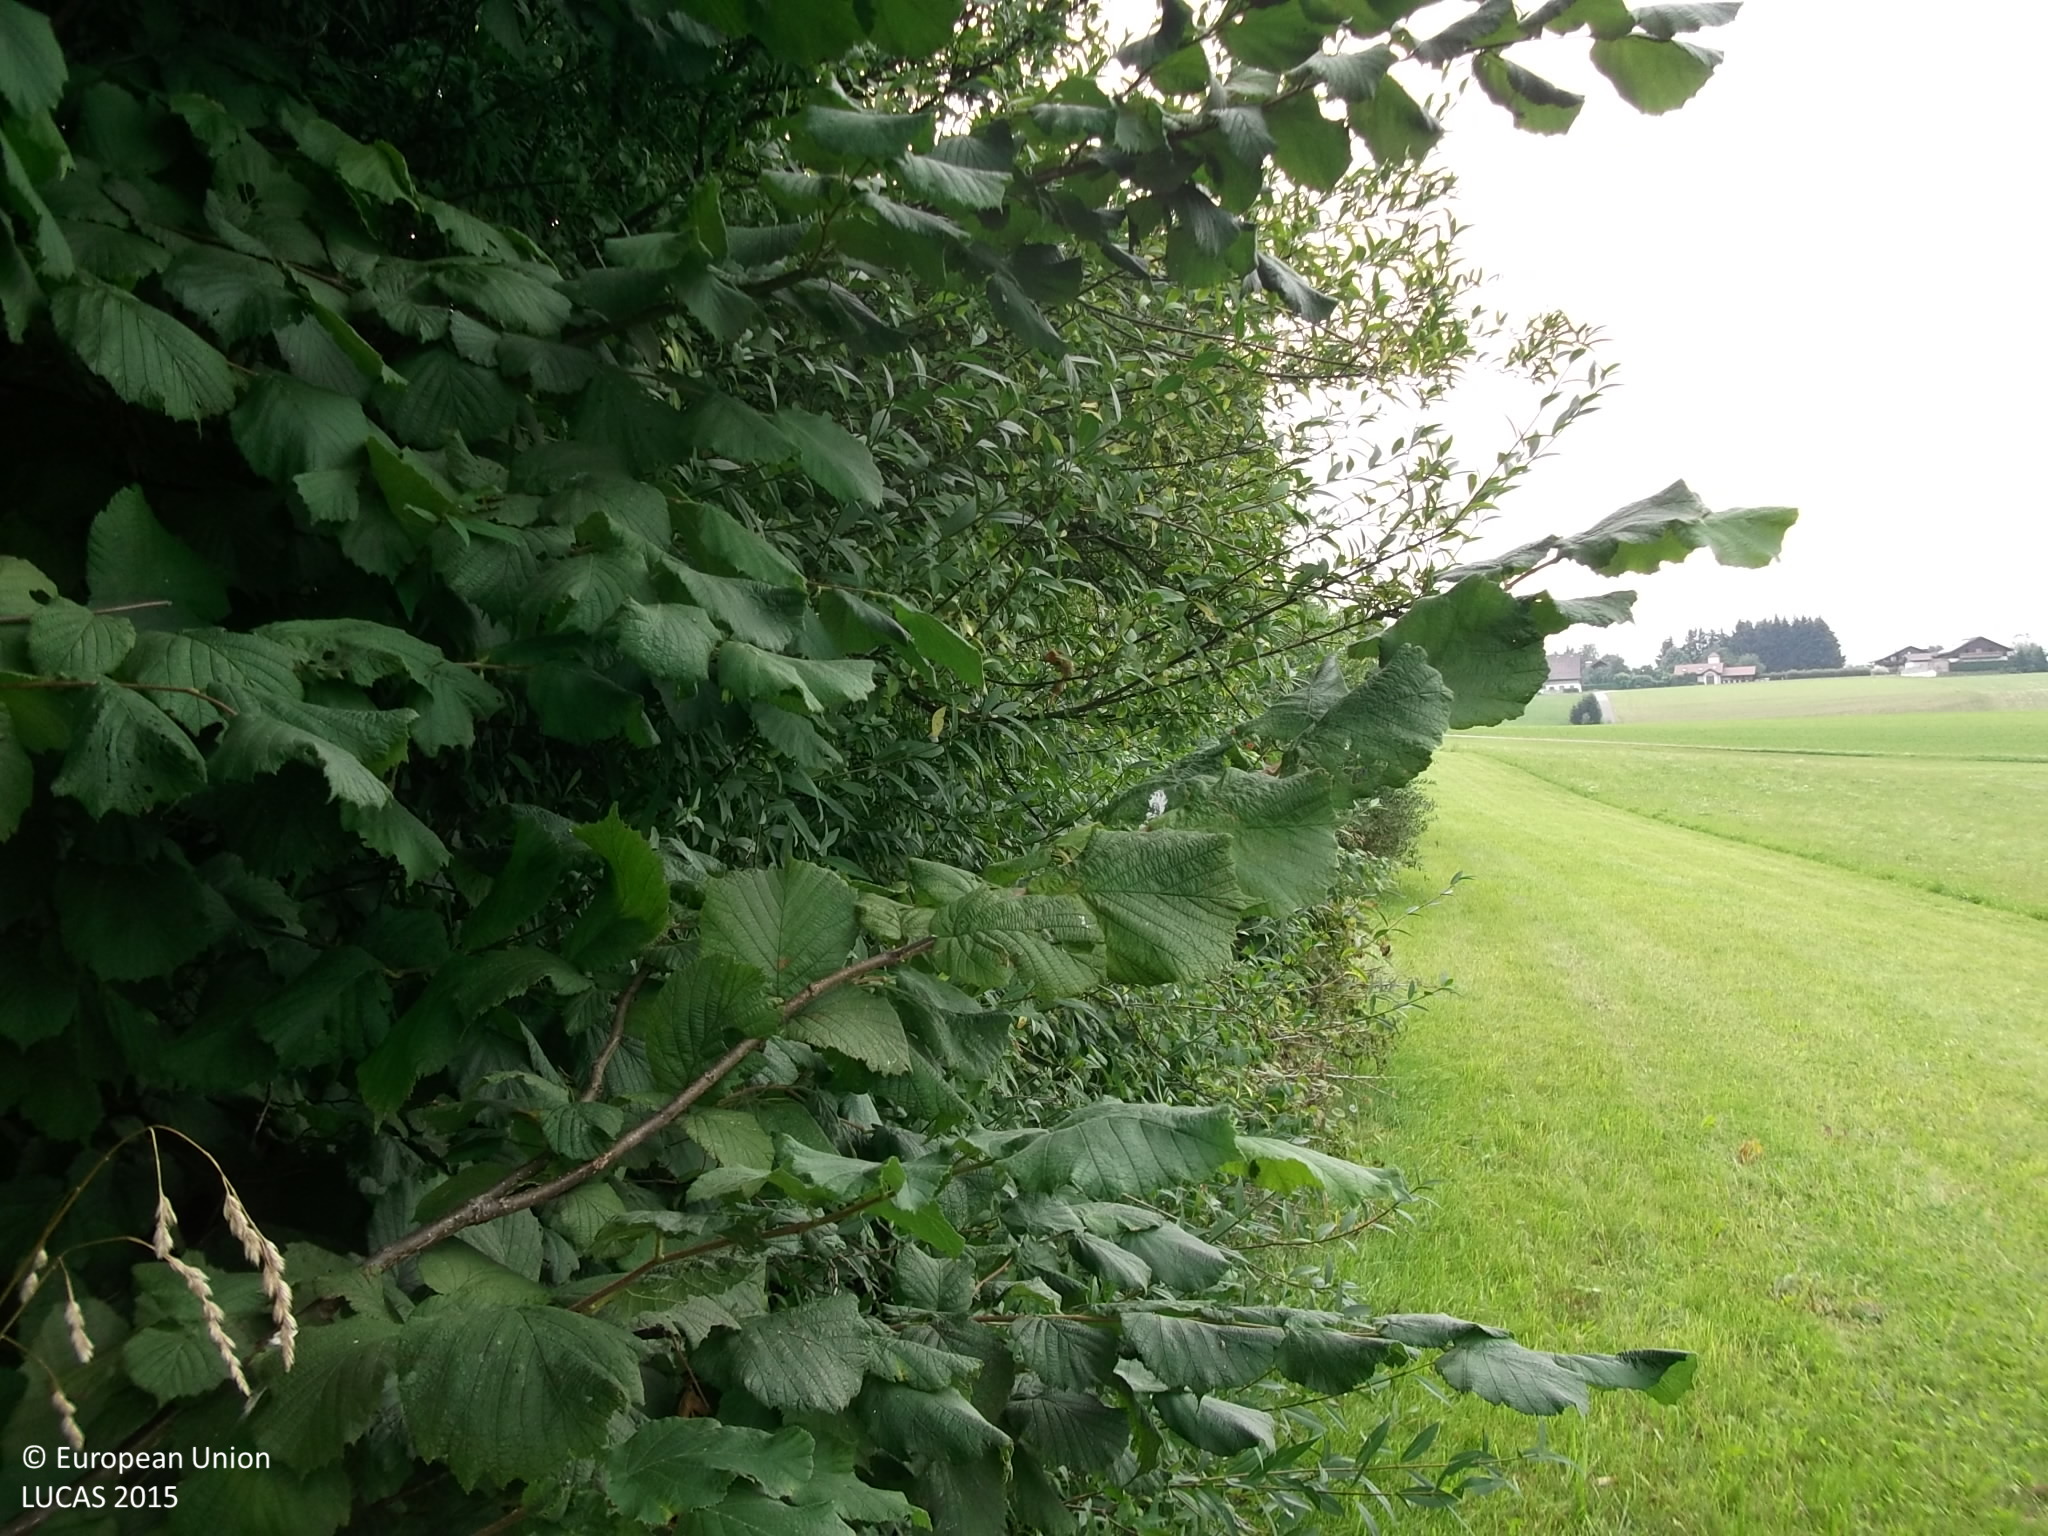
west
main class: Grassland
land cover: Grassland without tree/shrub cover
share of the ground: > 75 %
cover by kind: herbaceous plants 95 %, shrubs 5 %
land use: Agriculture (excluding fallow land and kitchen gardens)
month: August
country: AT
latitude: 47.9554
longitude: 13.3869
